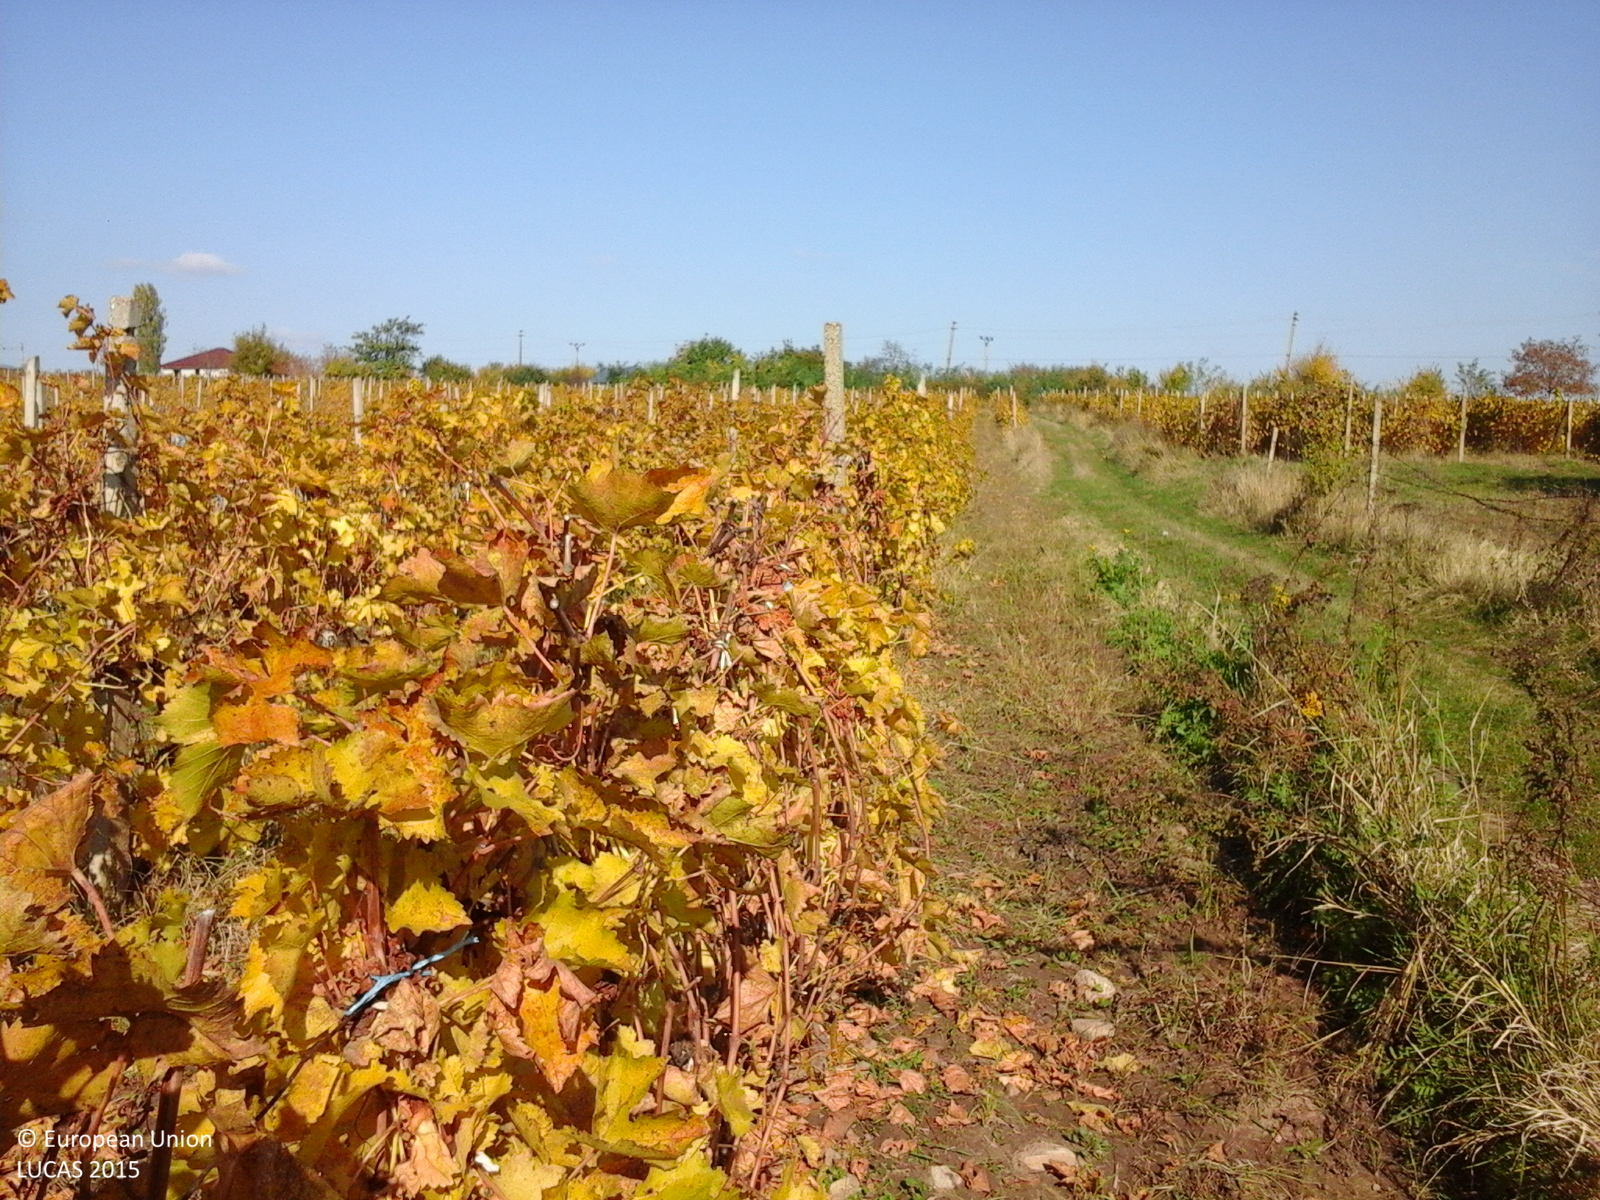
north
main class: Cropland
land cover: Vineyards
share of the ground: 50 - 75 %
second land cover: Other bare soil
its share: > 75 %
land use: Agriculture (excluding fallow land and kitchen gardens)
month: October
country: RO
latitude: 45.6296
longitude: 27.0610
